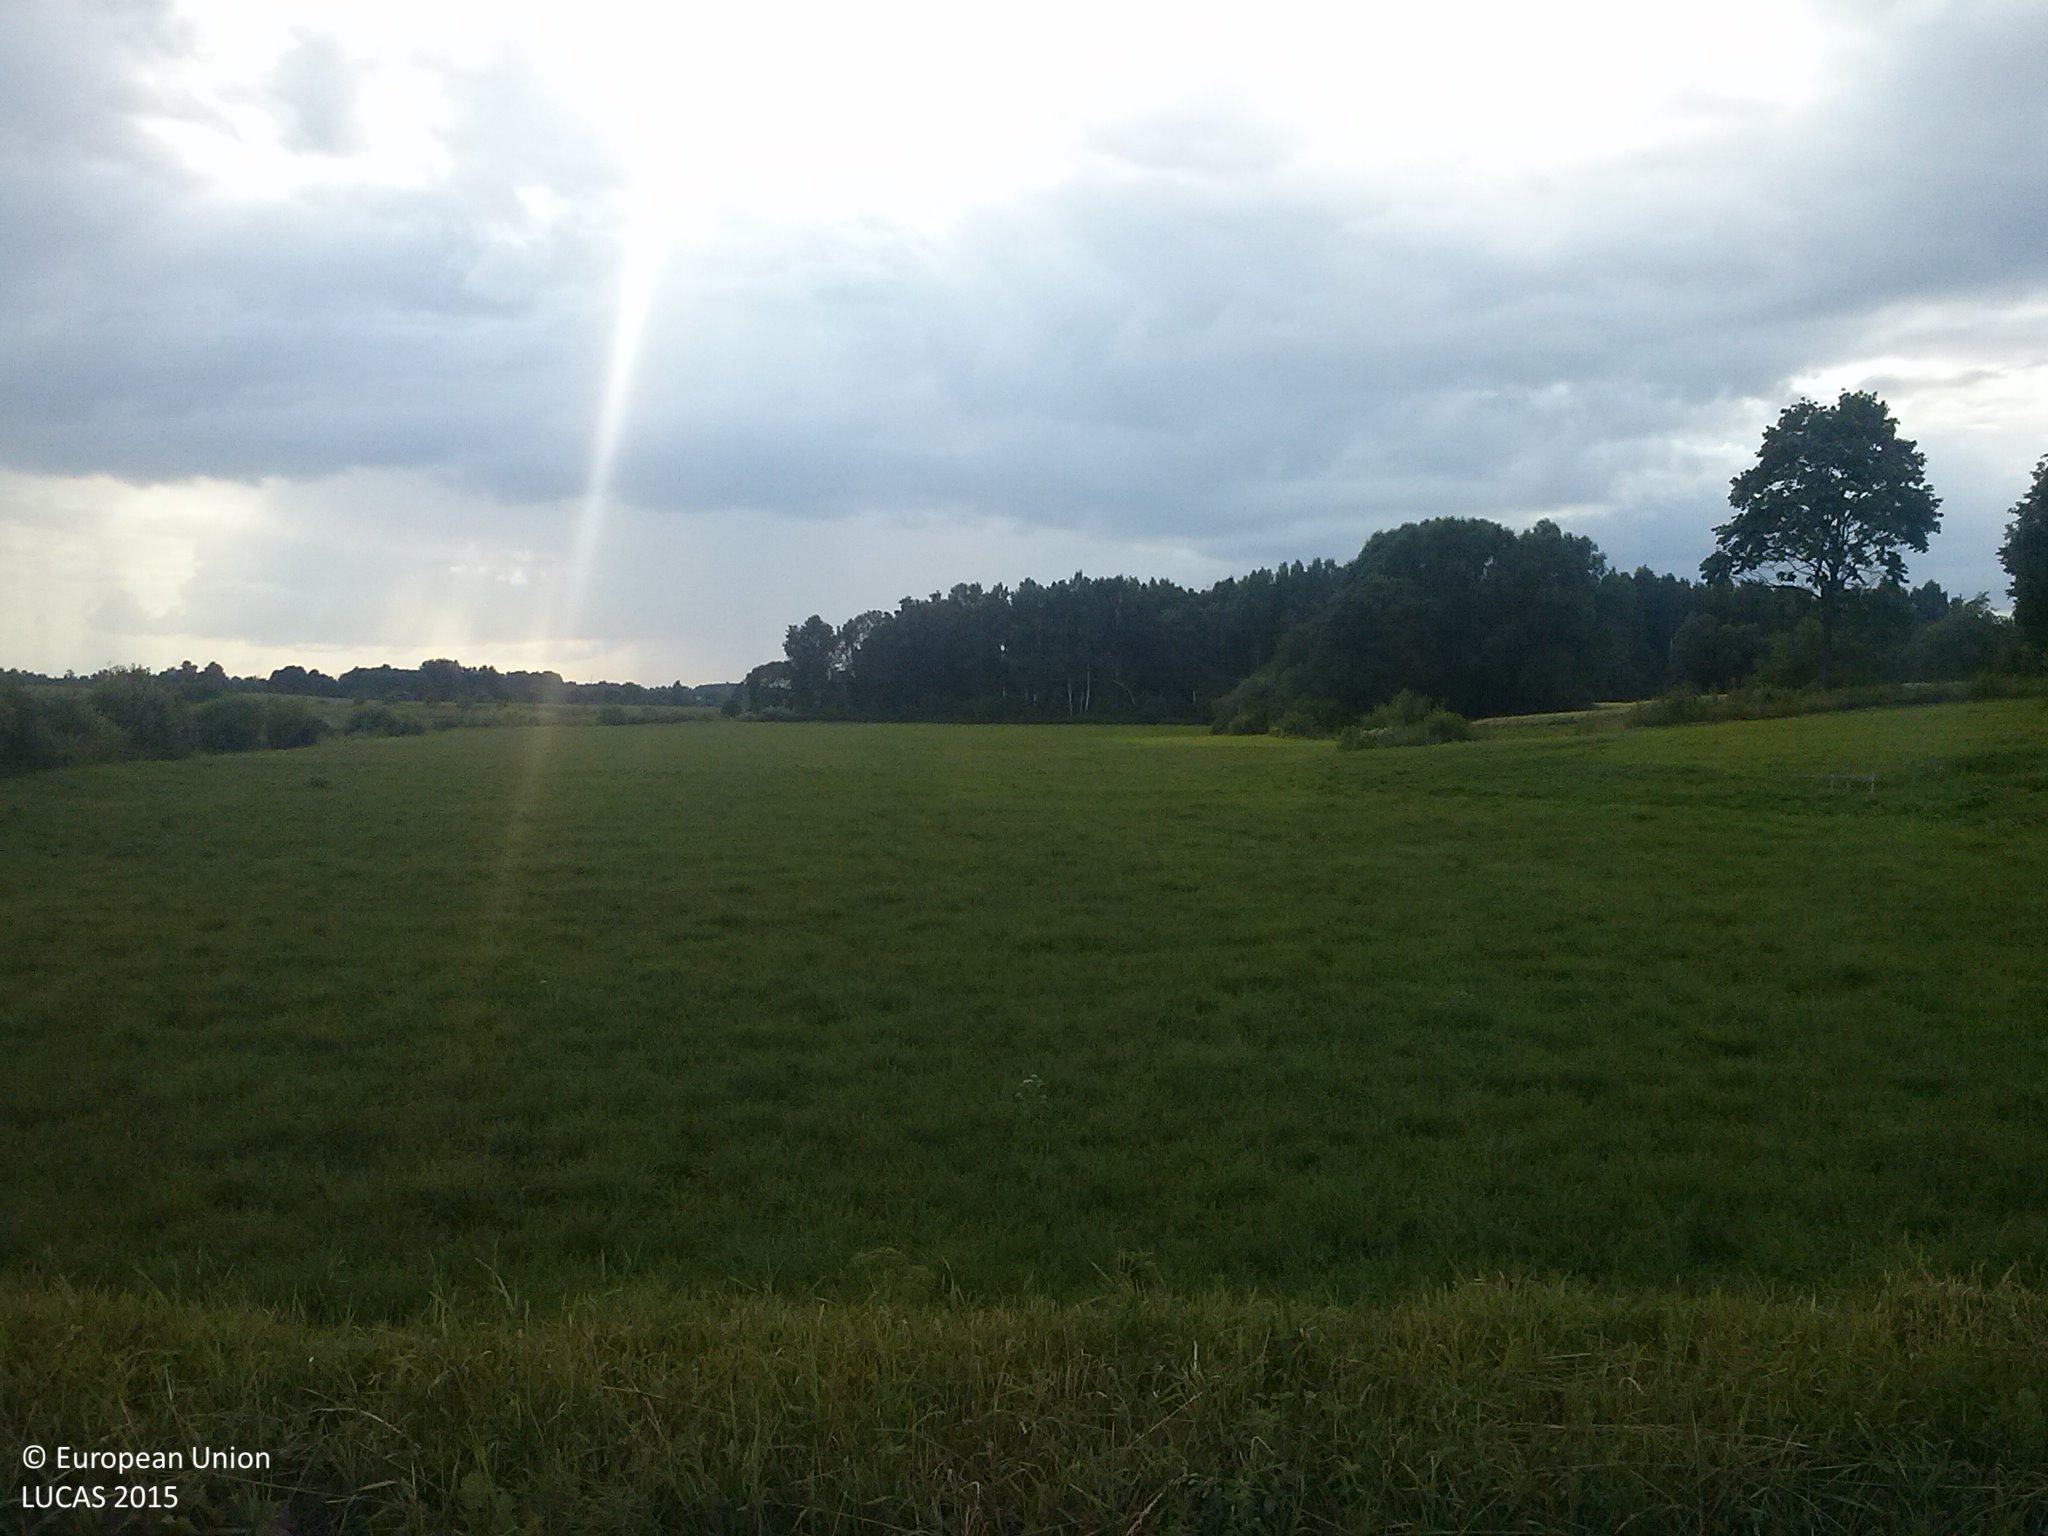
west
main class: Grassland
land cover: Grassland without tree/shrub cover
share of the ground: > 75 %
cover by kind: herbaceous plants 100 %
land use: Agriculture (excluding fallow land and kitchen gardens)
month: July
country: LV
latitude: 56.7176
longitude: 27.4130
